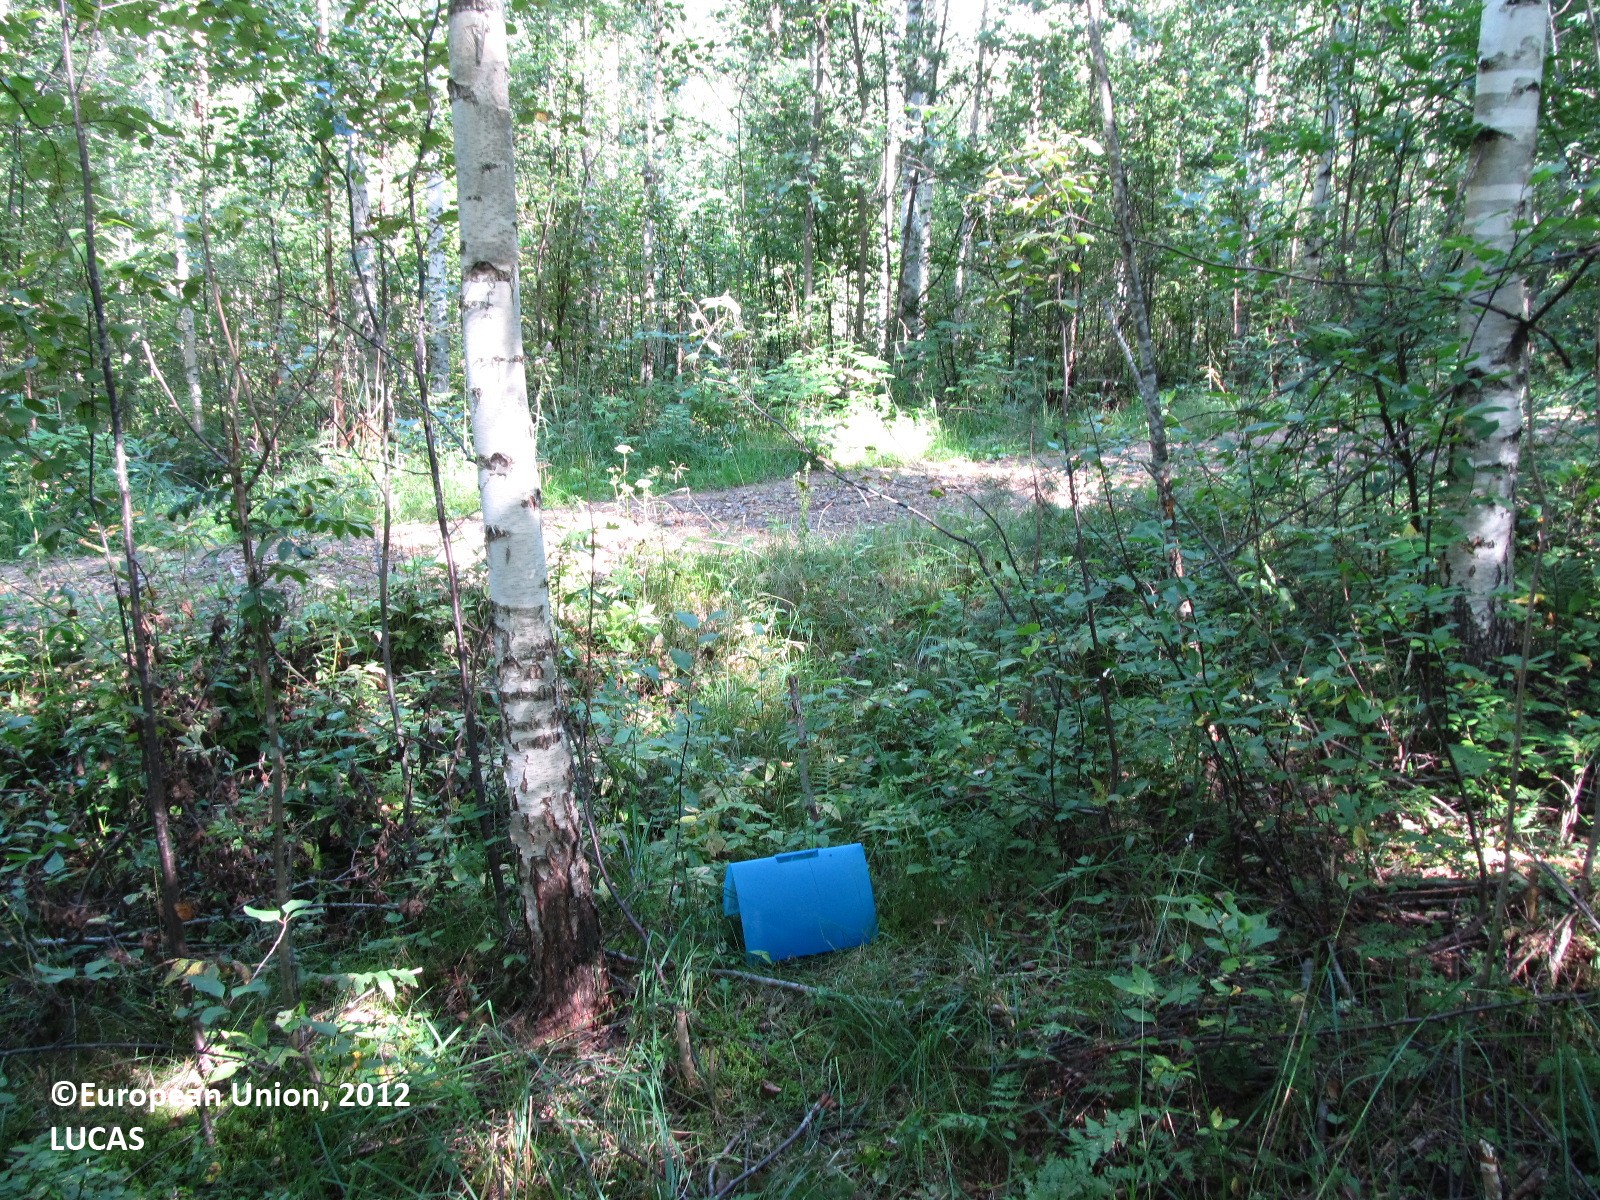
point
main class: Woodland
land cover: Broadleaved woodland
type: boreal forest
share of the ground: 50 - 75 %
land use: Forestry
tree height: > 5 m
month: August
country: FI
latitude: 62.1791
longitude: 28.4691
